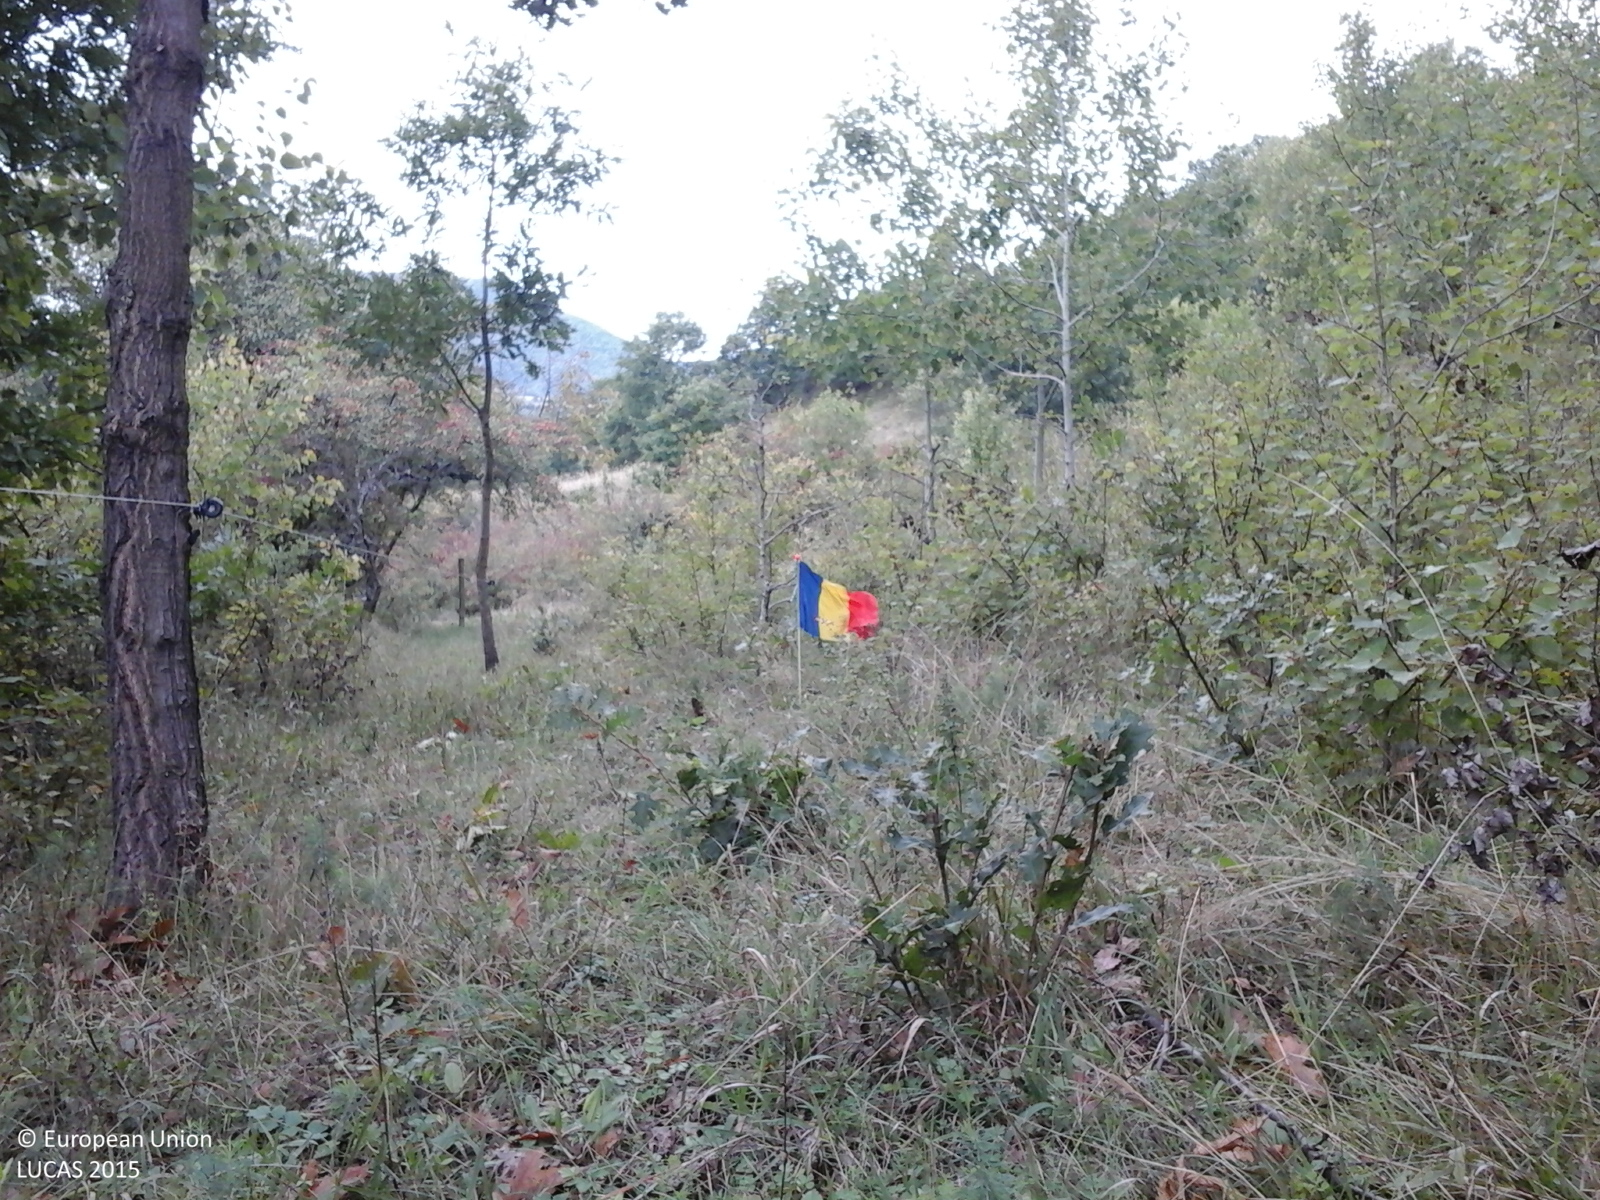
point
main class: Woodland
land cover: Broadleaved woodland
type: acidophilous oak and oak-birch forest
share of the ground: > 75 %
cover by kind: broadleaved forest trees 100 %
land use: Forestry
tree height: > 5 m
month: September
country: RO
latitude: 45.9960
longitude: 23.1114
